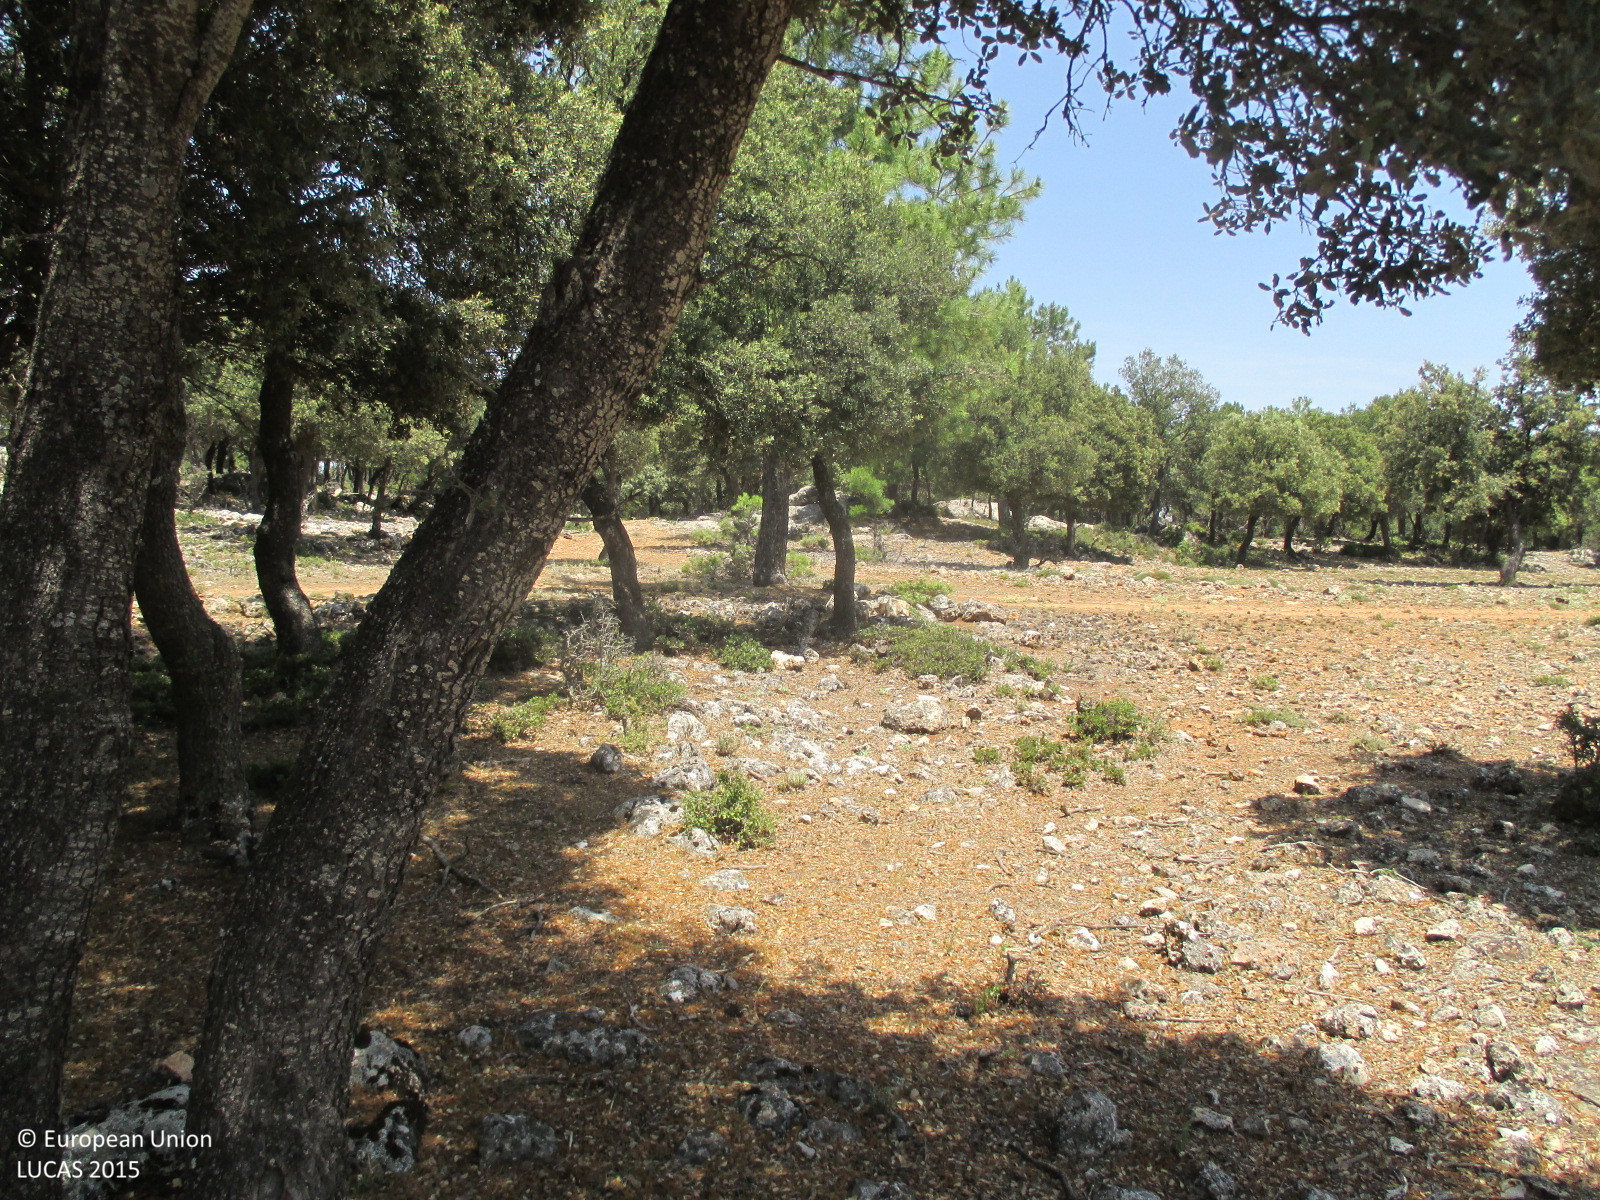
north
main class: Woodland
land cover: Broadleaved woodland
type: broadleaved evergreen forest
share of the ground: > 75 %
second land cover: Grassland without tree/shrub cover
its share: > 75 %
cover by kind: broadleaved forest trees 75 %, herbaceous plants 25 %
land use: Forestry
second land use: Agriculture (excluding fallow land and kitchen gardens)
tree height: > 5 m
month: July
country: ES
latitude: 38.0887
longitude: -2.5242
